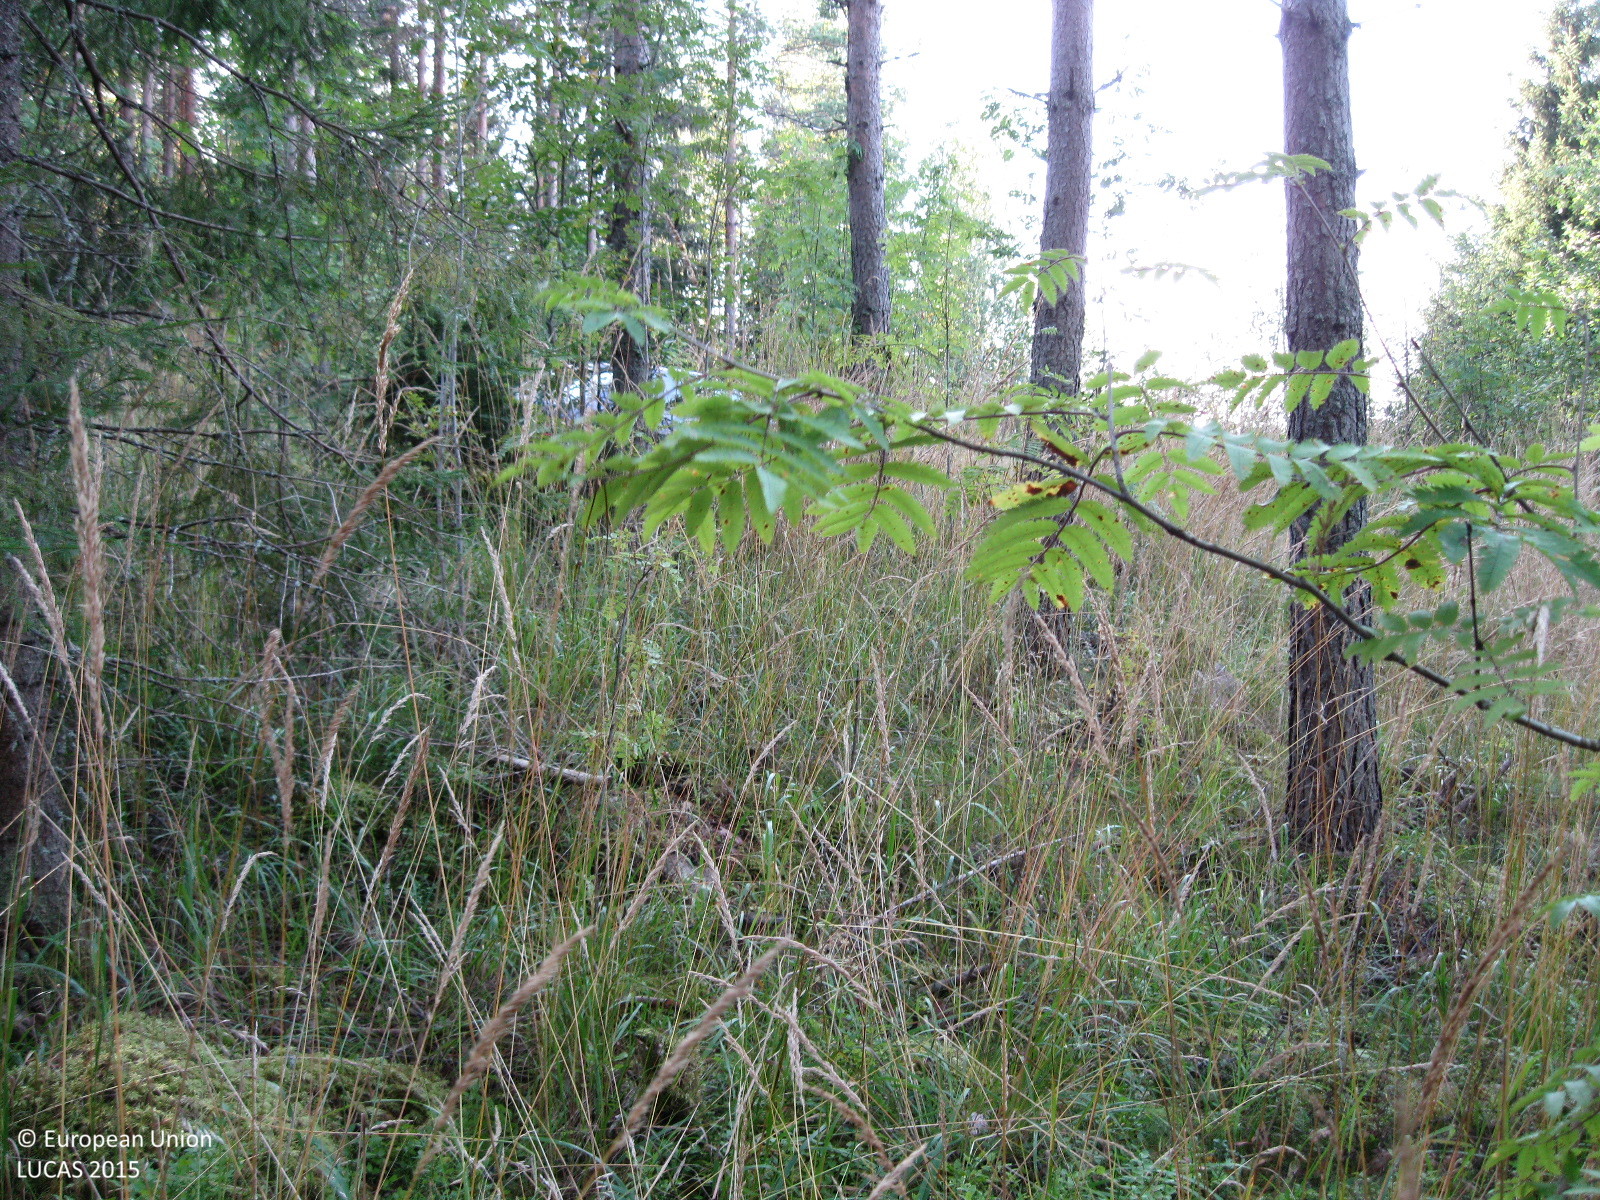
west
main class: Woodland
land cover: Pine dominated coniferous woodland
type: boreal forest
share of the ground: > 75 %
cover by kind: coniferous forest trees 70 %, herbaceous plants 25 %, broadleaved forest trees 5 %
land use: Forestry
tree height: > 5 m
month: September
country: FI
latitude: 60.5352
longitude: 24.5973
